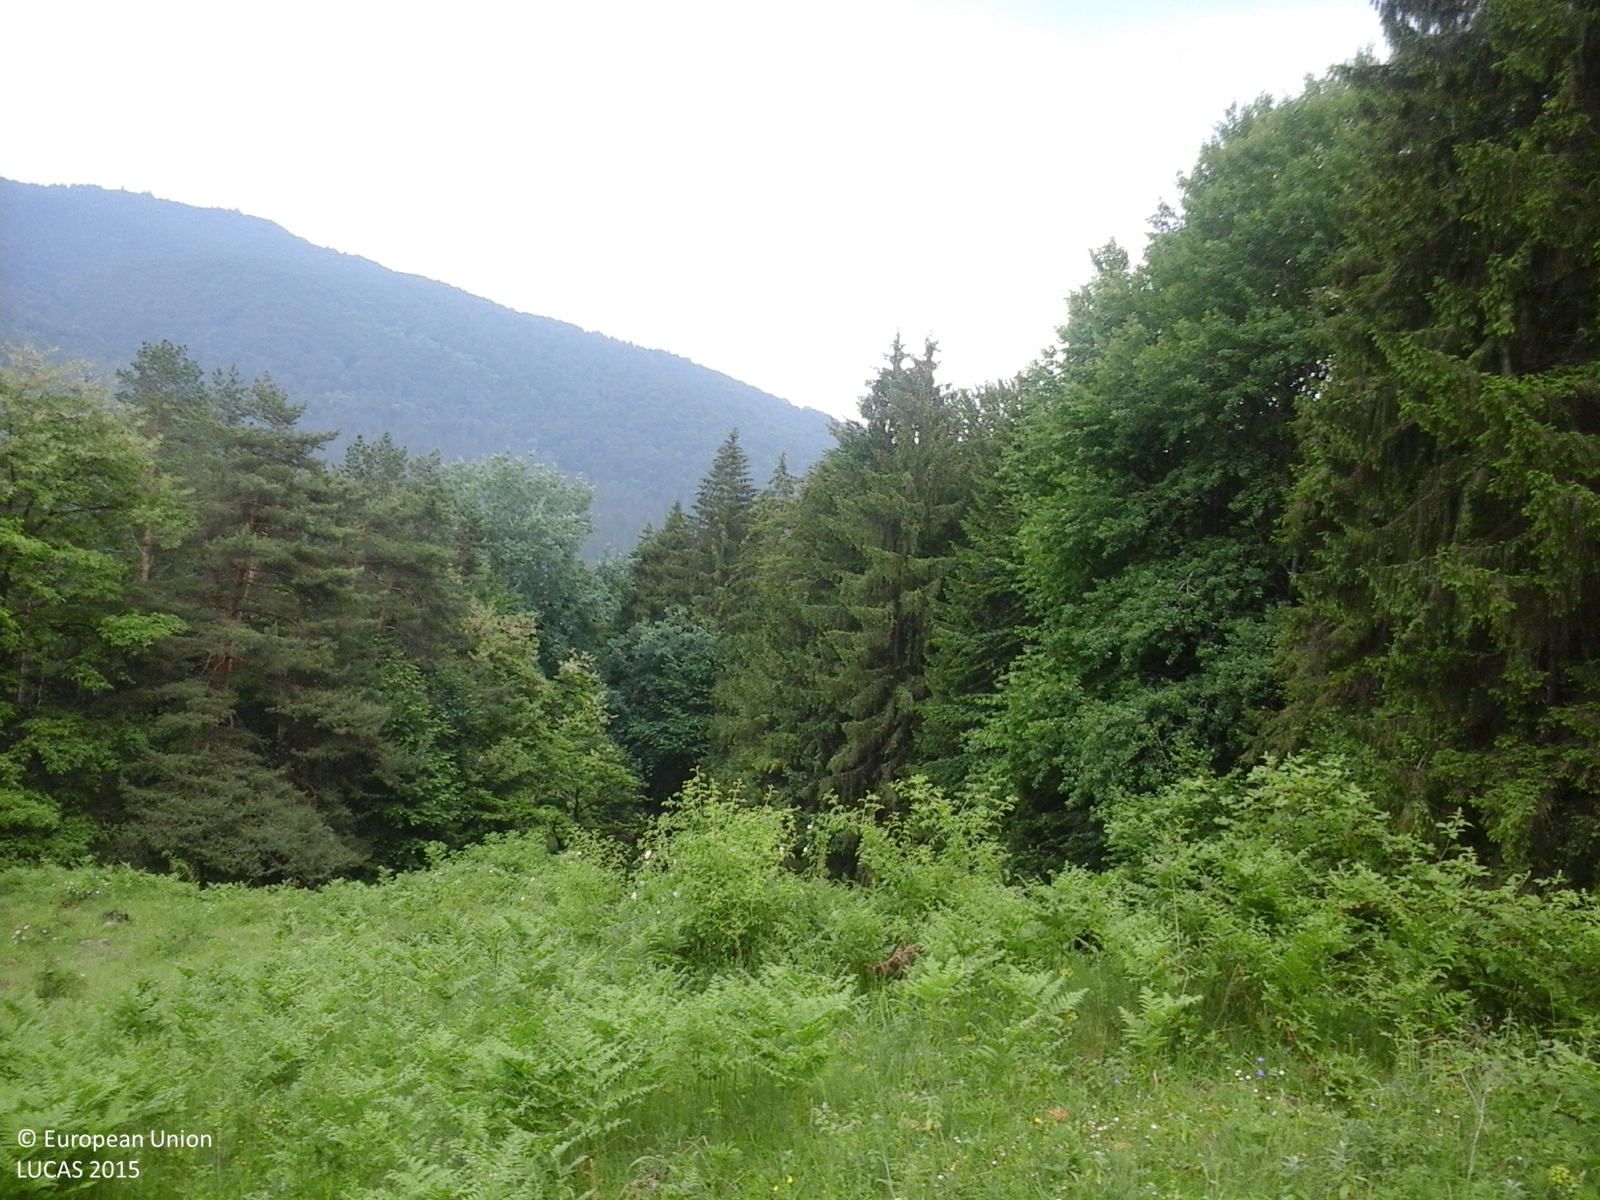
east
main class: Grassland
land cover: Grassland with sparse tree/shrub cover
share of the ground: > 75 %
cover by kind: herbaceous plants 85 %, shrubs 10 %, broadleaved forest trees 5 %
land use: Agriculture (excluding fallow land and kitchen gardens)
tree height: > 5 m
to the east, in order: Grassland with sparse tree/shrub cover; Fences; Other mixed woodland; Railways; Other mixed woodland
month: June
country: RO
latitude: 46.9010
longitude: 26.1023
